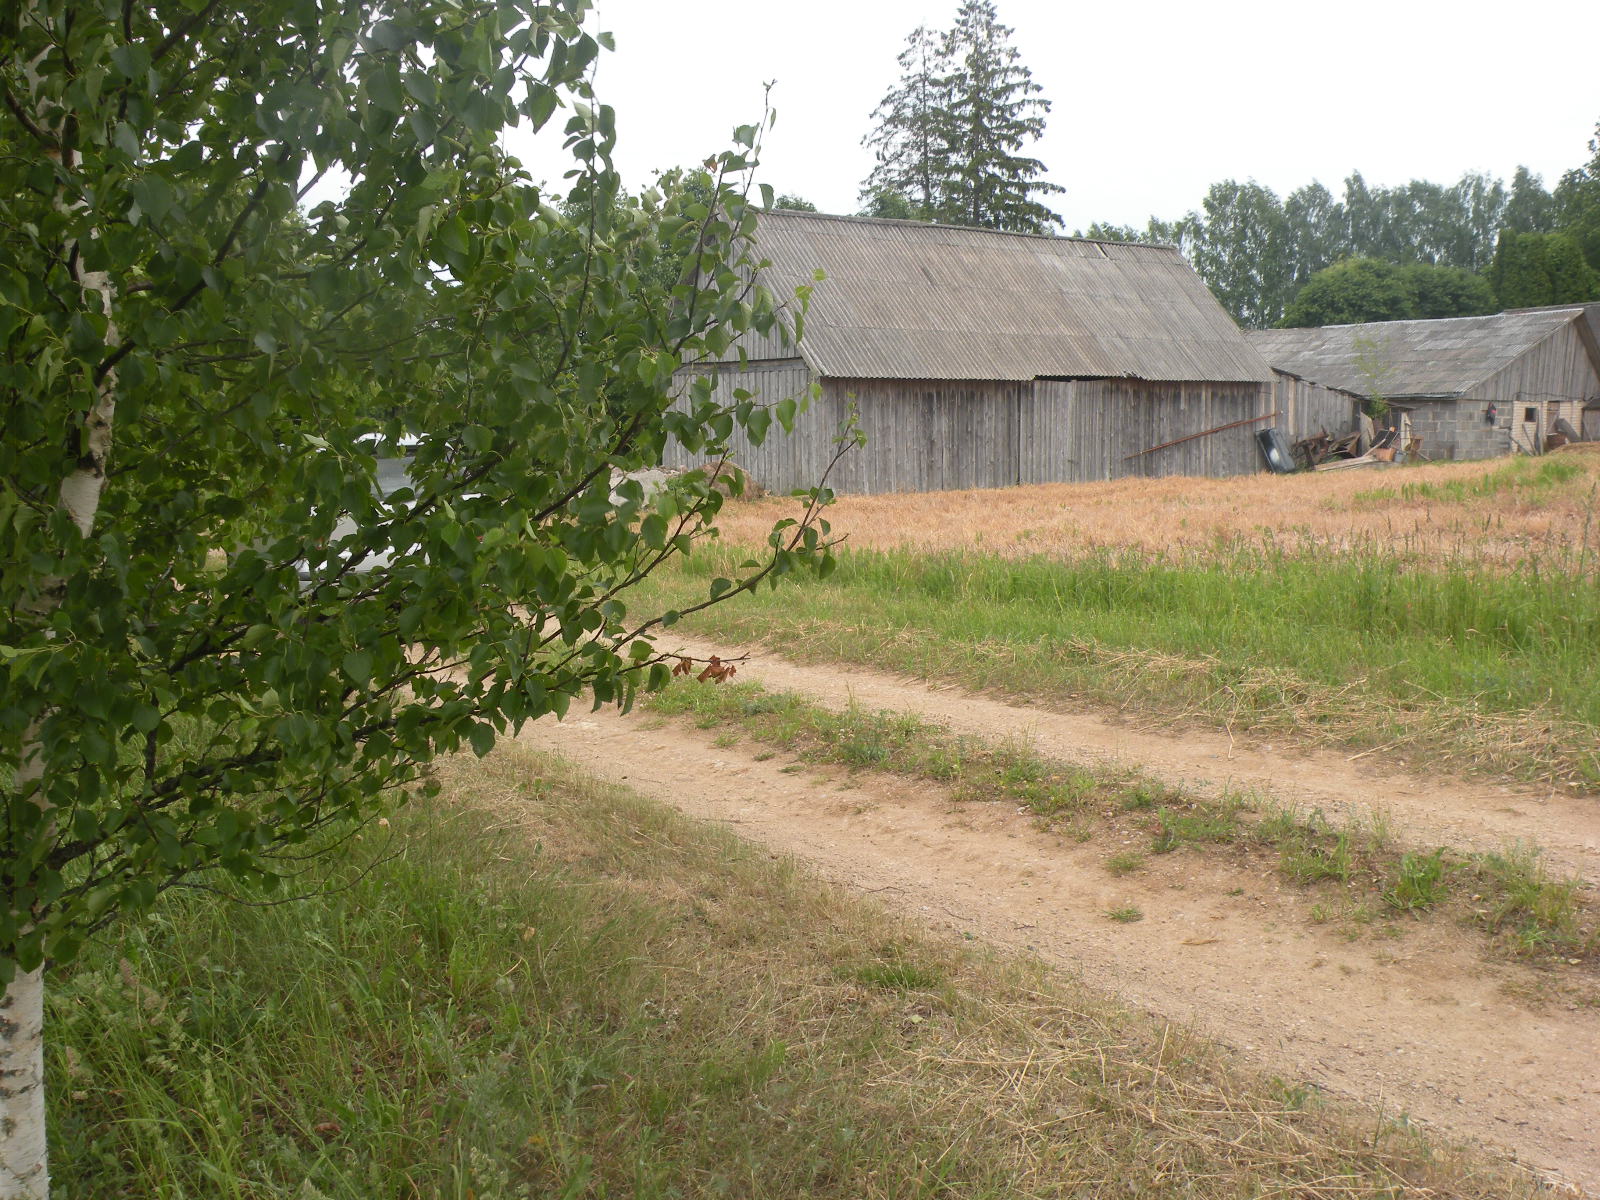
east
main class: Grassland
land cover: Grassland without tree/shrub cover
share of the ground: > 75 %
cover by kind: herbaceous plants 100 %
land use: Agriculture (excluding fallow land and kitchen gardens)
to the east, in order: Grassland without tree/shrub cover; Lines of trees; Artificial constructions in urban areas; Apple fruit; Grassland without tree/shrub cover; Barley; Electric lines; Barley; Grassland without tree/shrub cover; Ditches and canals; Barley
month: June
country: LV
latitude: 56.0516
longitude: 26.7432
